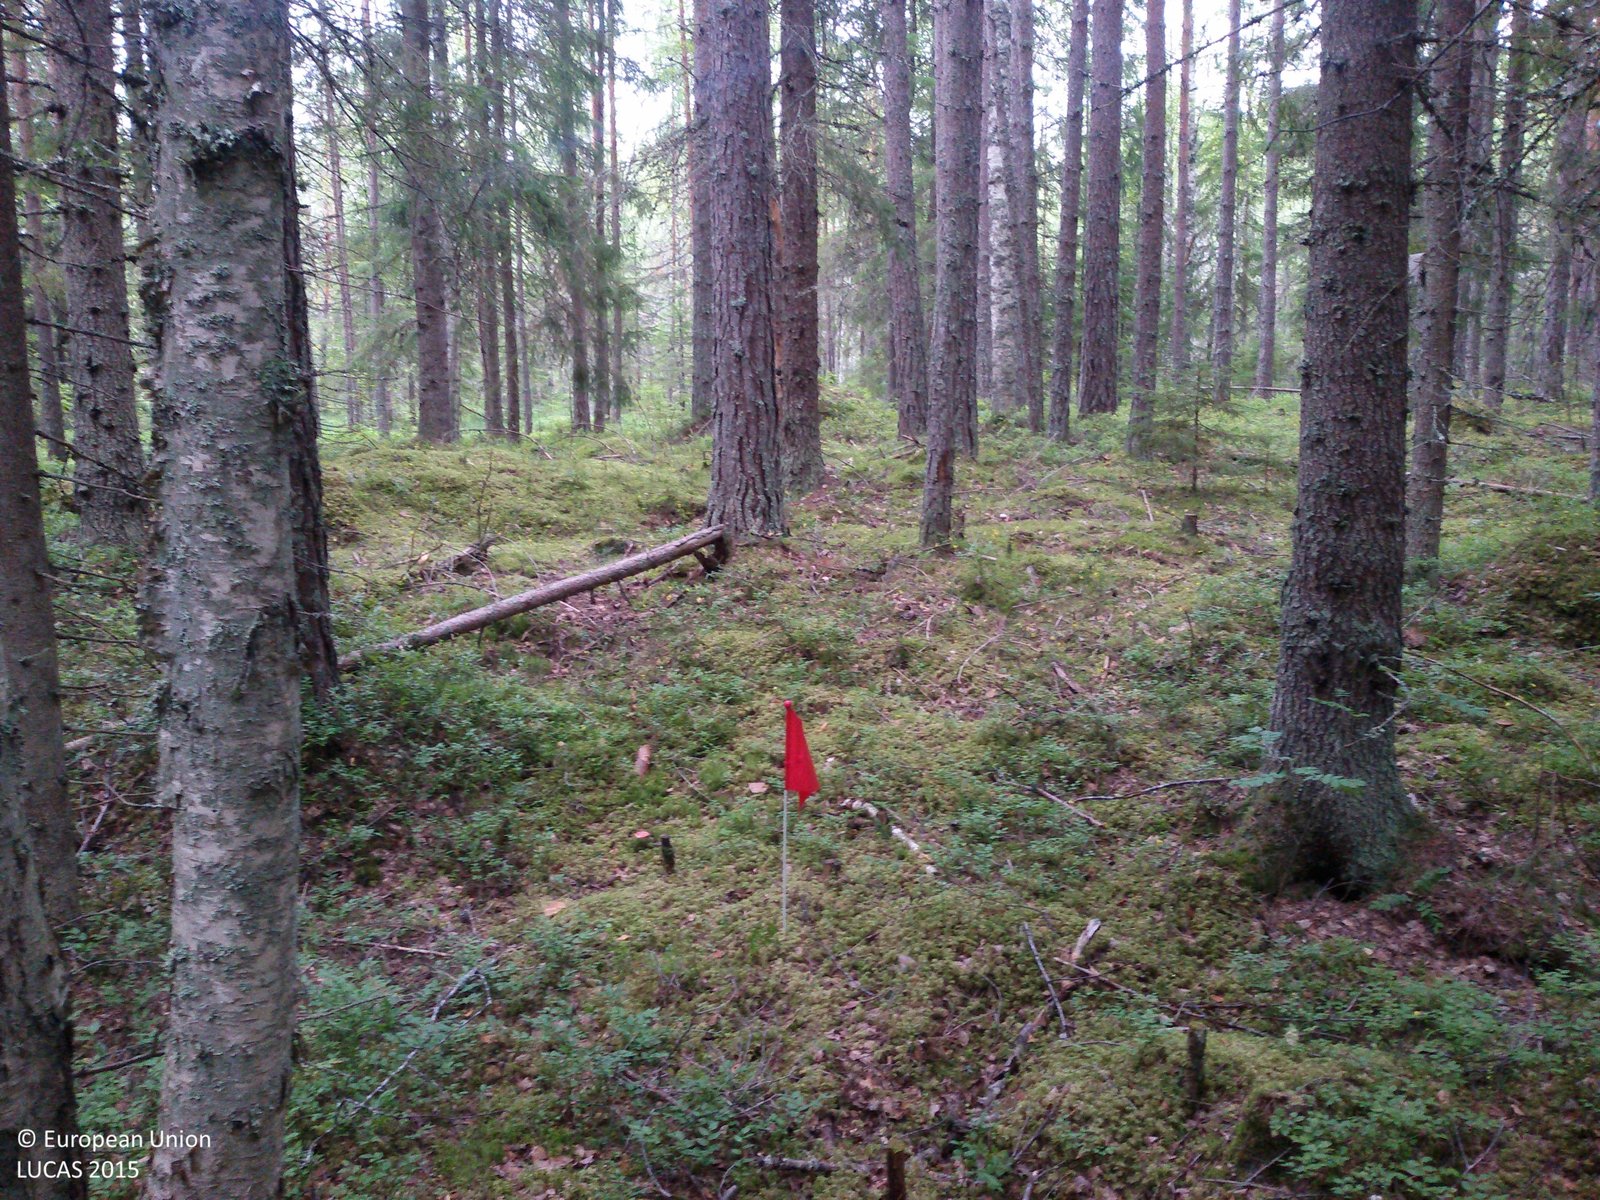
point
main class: Woodland
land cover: Spruce dominated mixed woodland
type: boreal forest
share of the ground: > 75 %
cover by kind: coniferous forest trees 55 %, broadleaved forest trees 30 %, lichens and mosses 10 %, herbaceous plants 5 %
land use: Forestry
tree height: > 5 m
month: August
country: SE
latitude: 60.6574
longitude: 16.6289
